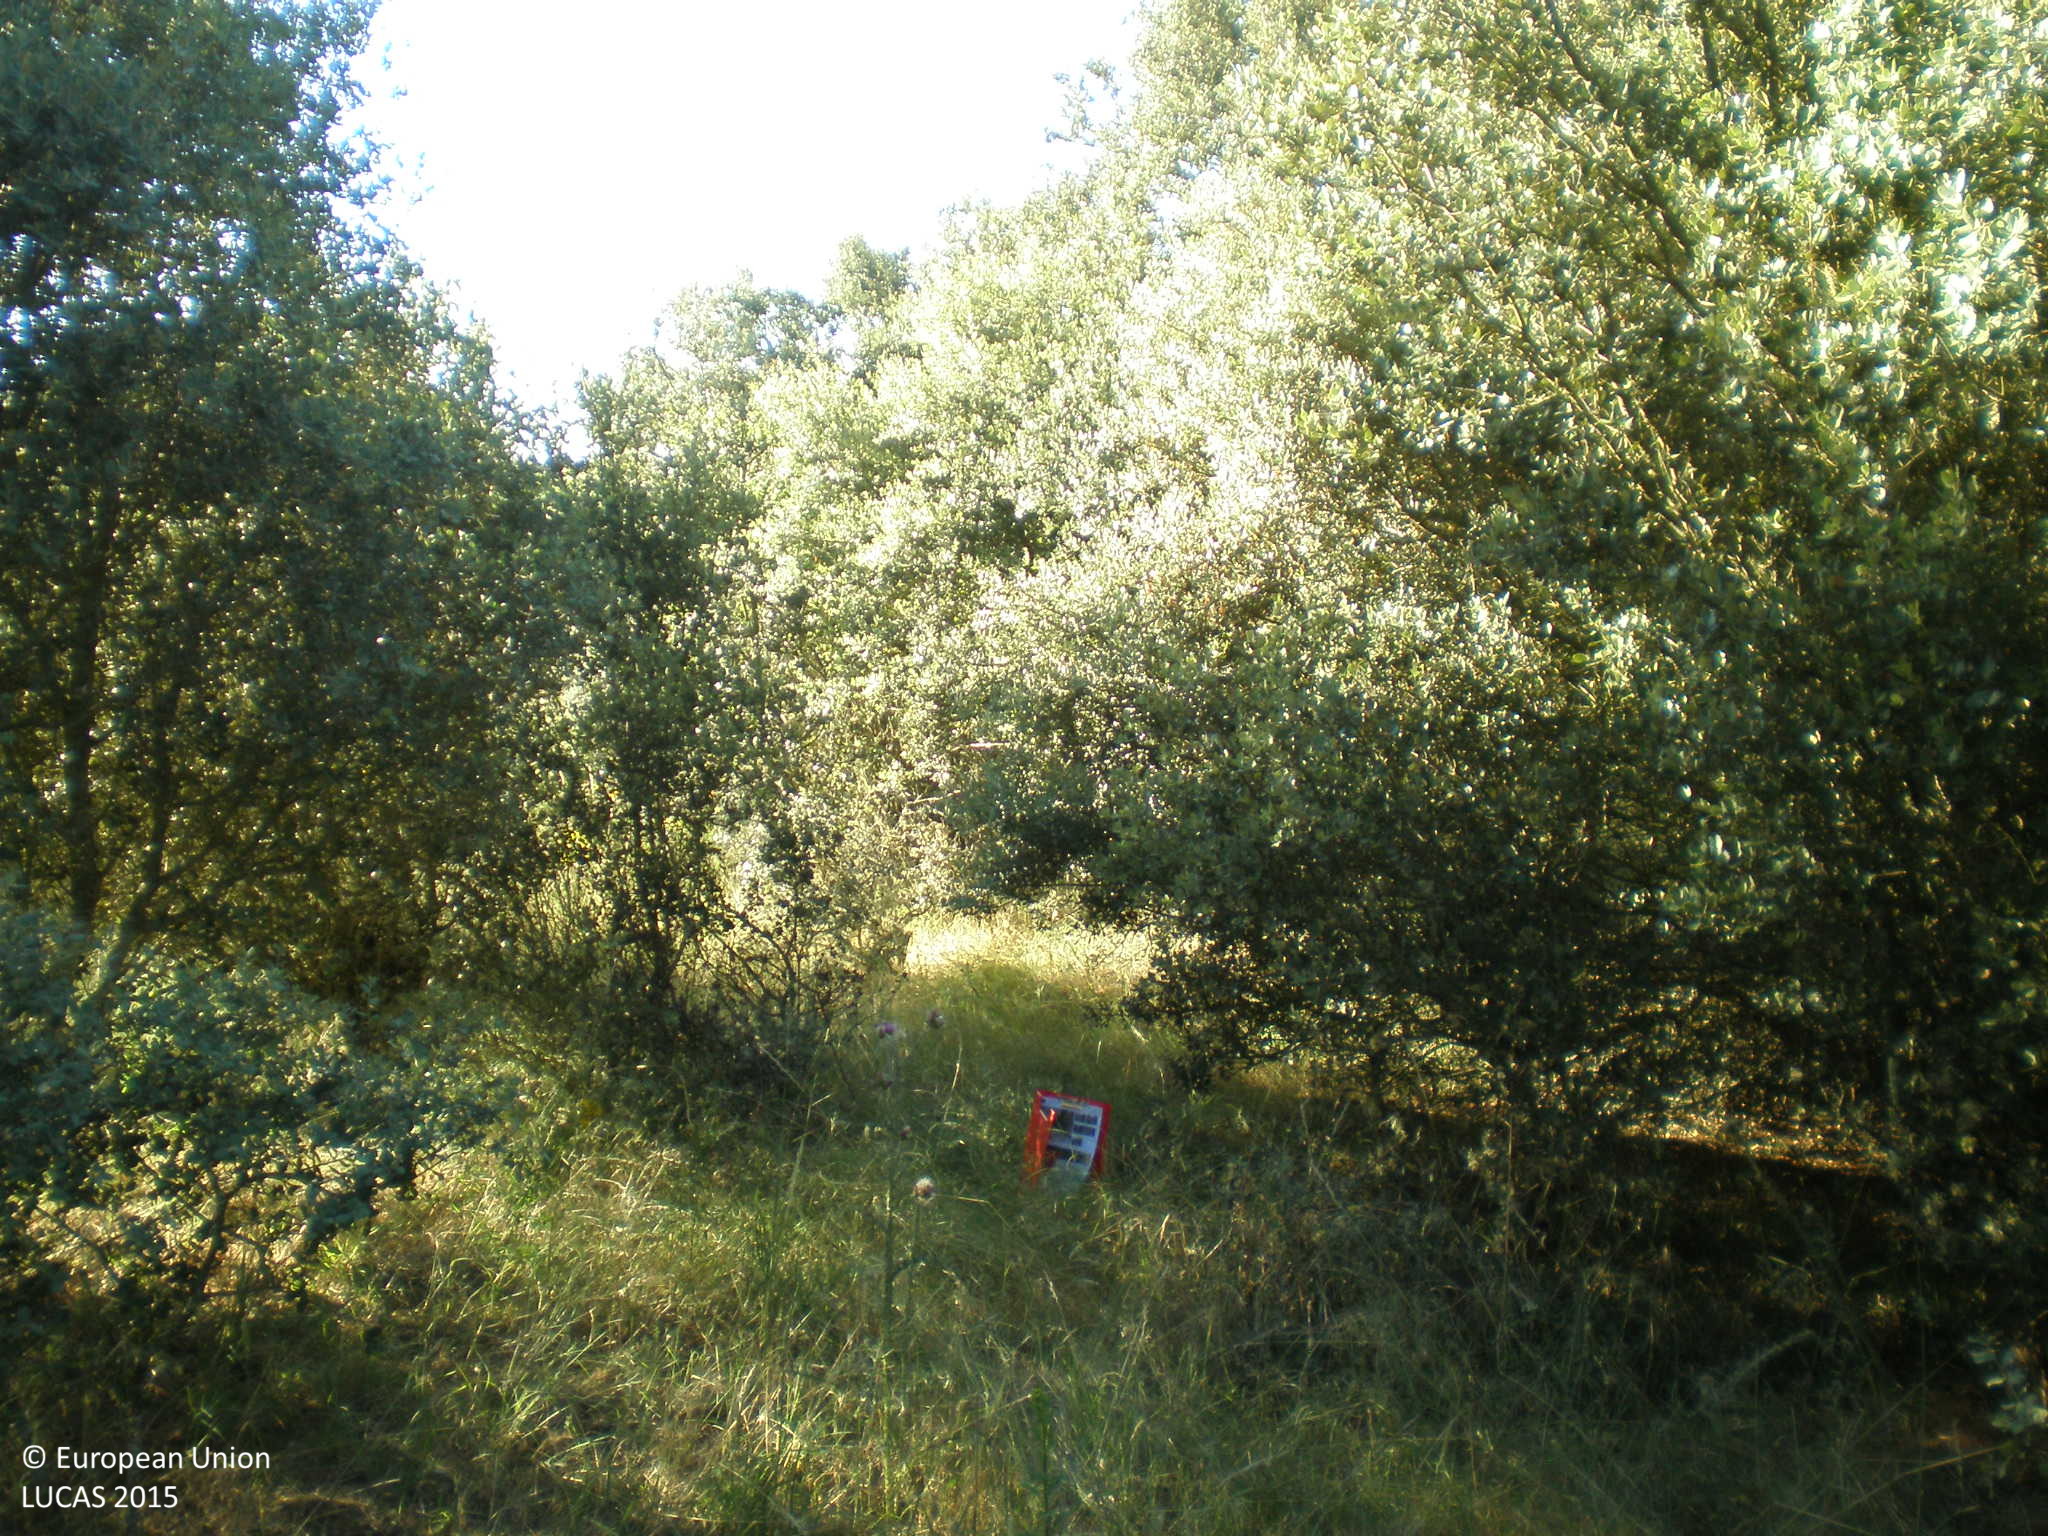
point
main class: Woodland
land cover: Broadleaved woodland
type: broadleaved evergreen forest
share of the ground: 25 - 50 %
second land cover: Grassland without tree/shrub cover
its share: 50 - 75 %
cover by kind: herbaceous plants 55 %, broadleaved forest trees 45 %
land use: Forestry
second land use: Agriculture (excluding fallow land and kitchen gardens)
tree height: > 5 m
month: June
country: ES
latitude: 40.7419
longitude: -5.6947
